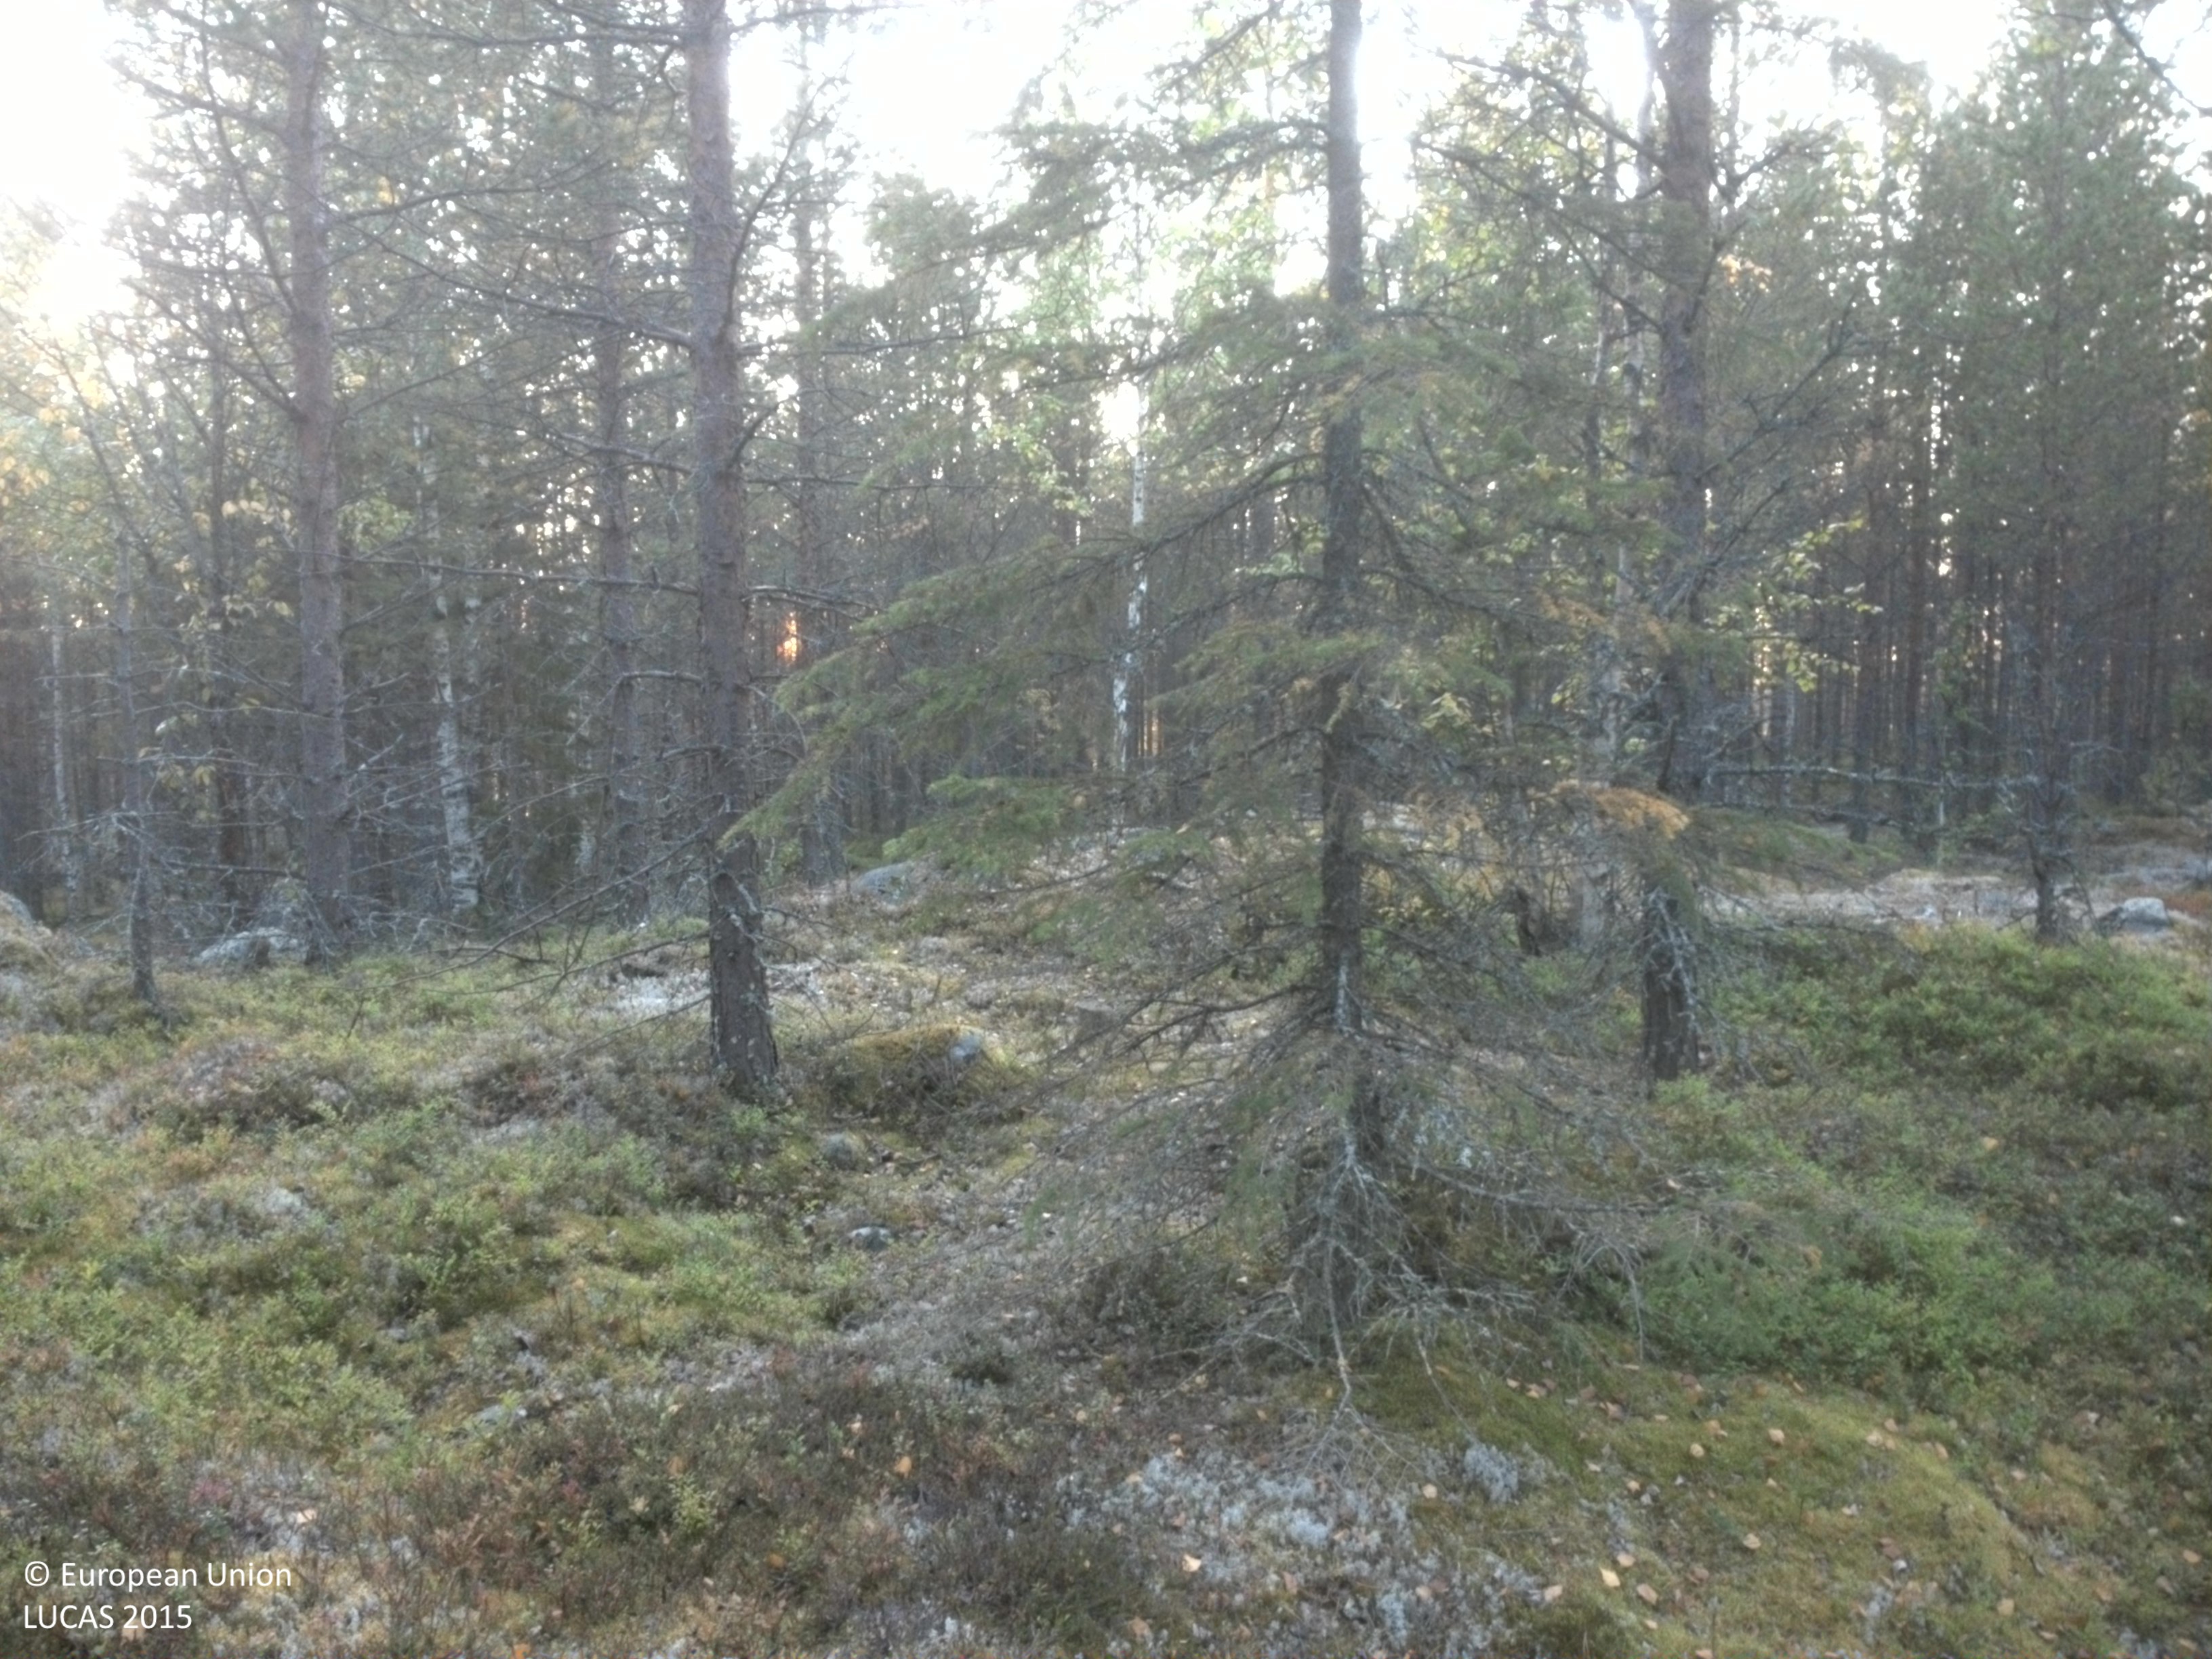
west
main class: Woodland
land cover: Pine dominated coniferous woodland
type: boreal forest
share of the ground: 25 - 50 %
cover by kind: coniferous forest trees 40 %, lichens and mosses 25 %, shrubs 20 %, herbaceous plants 10 %, broadleaved forest trees 5 %
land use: Forestry
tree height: > 5 m
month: September
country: SE
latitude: 64.4280
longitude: 20.0037
